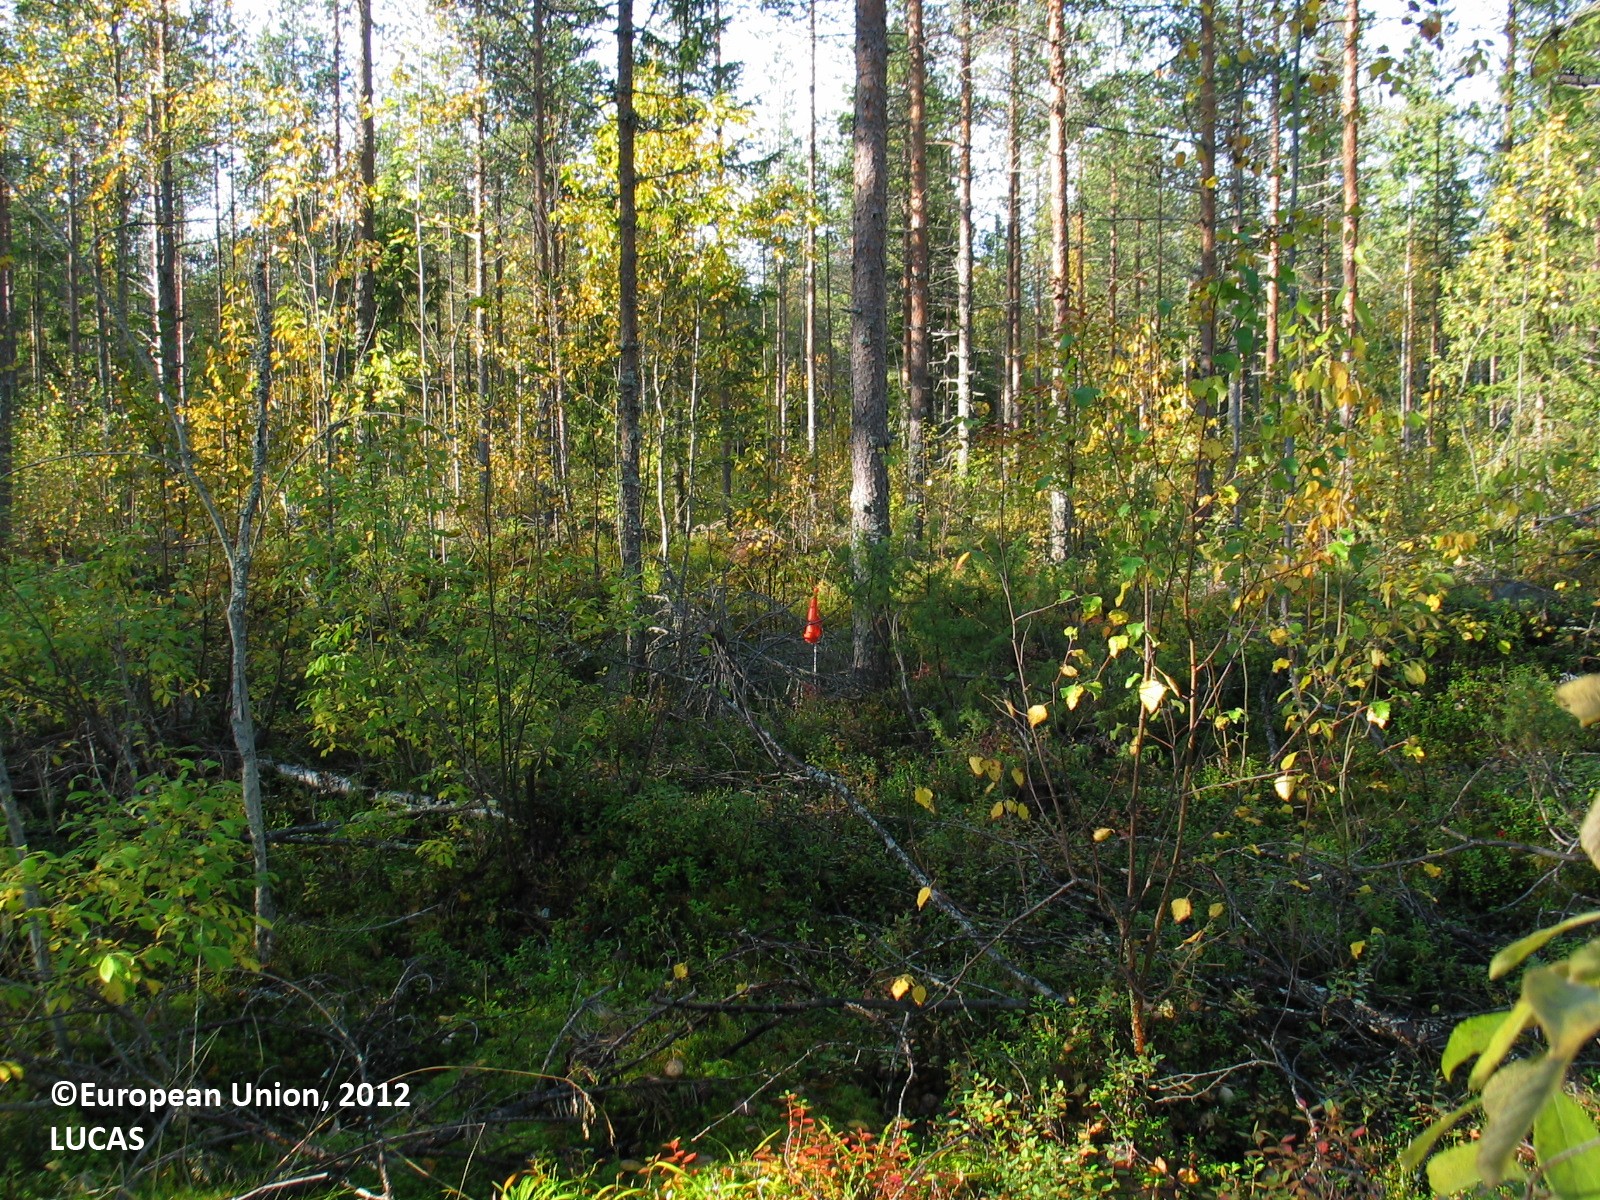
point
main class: Woodland
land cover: Pine dominated coniferous woodland
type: boreal forest
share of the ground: 25 - 50 %
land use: Forestry
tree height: > 5 m
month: September
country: FI
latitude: 65.5091
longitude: 25.5798
